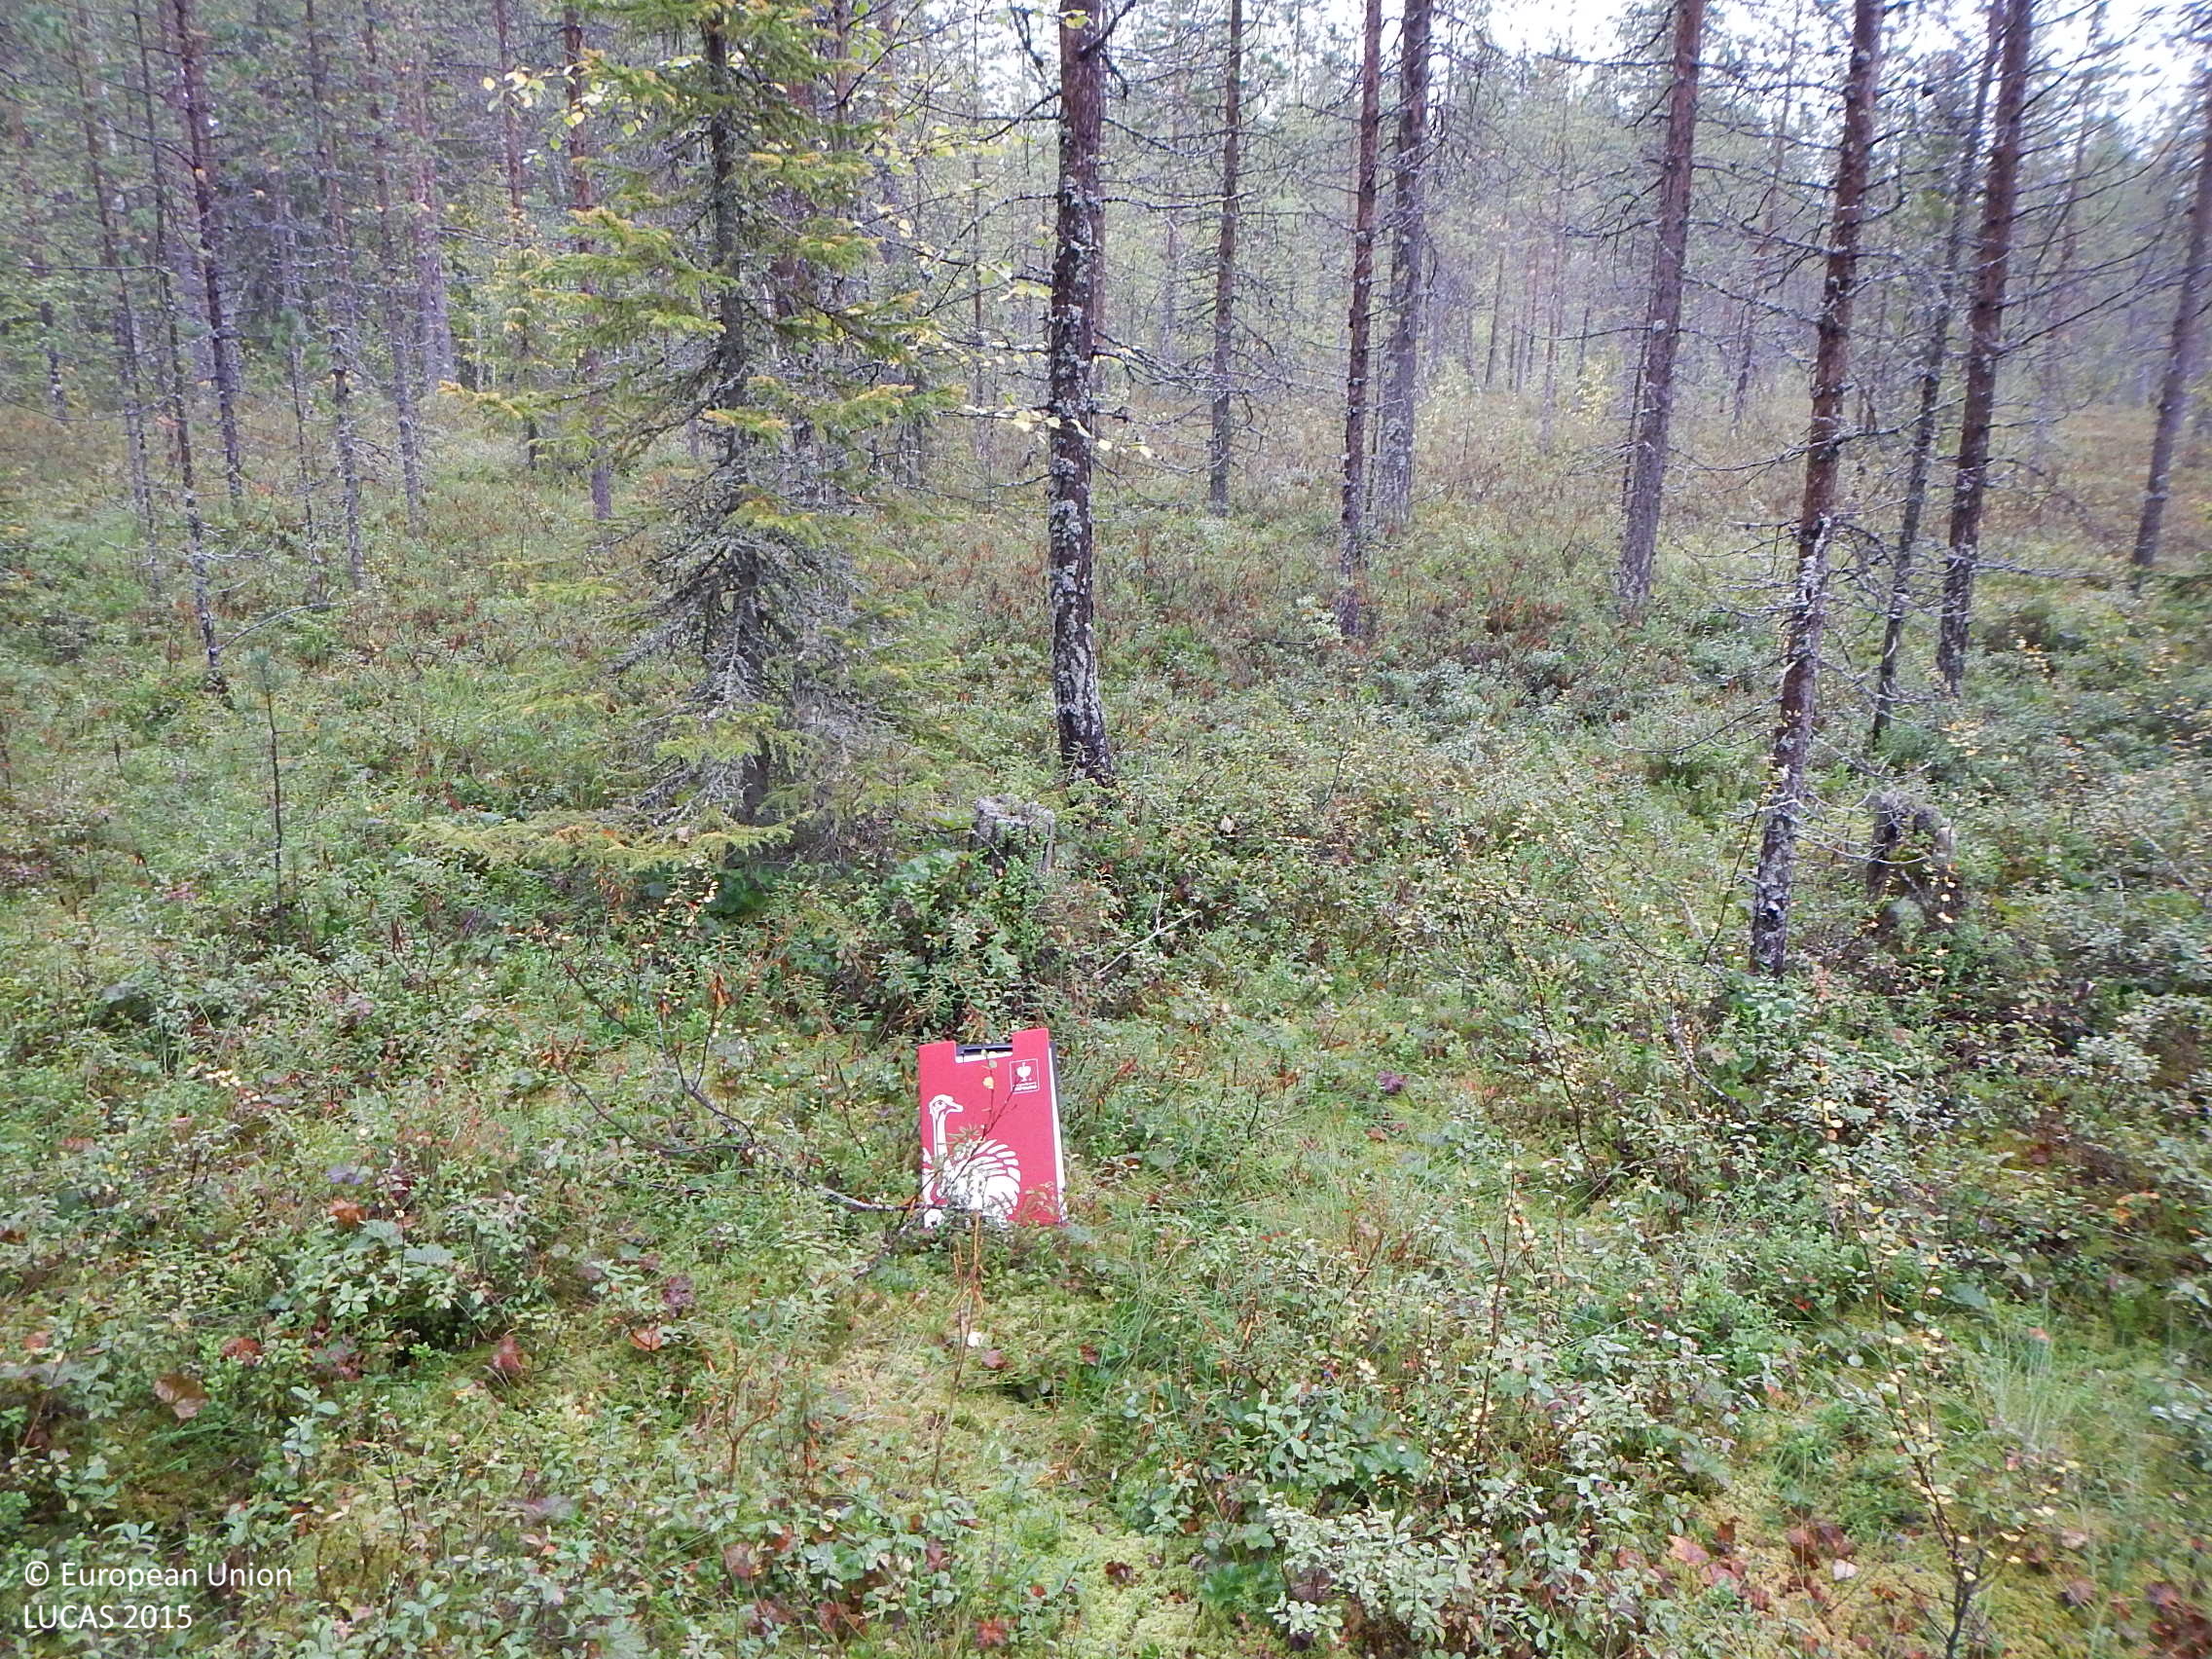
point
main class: Woodland
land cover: Pine dominated coniferous woodland
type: boreal forest
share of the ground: 50 - 75 %
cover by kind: coniferous forest trees 60 %, shrubs 20 %, broadleaved forest trees 10 %, herbaceous plants 10 %
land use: Forestry
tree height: > 5 m
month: August
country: FI
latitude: 65.9762
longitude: 27.3994
